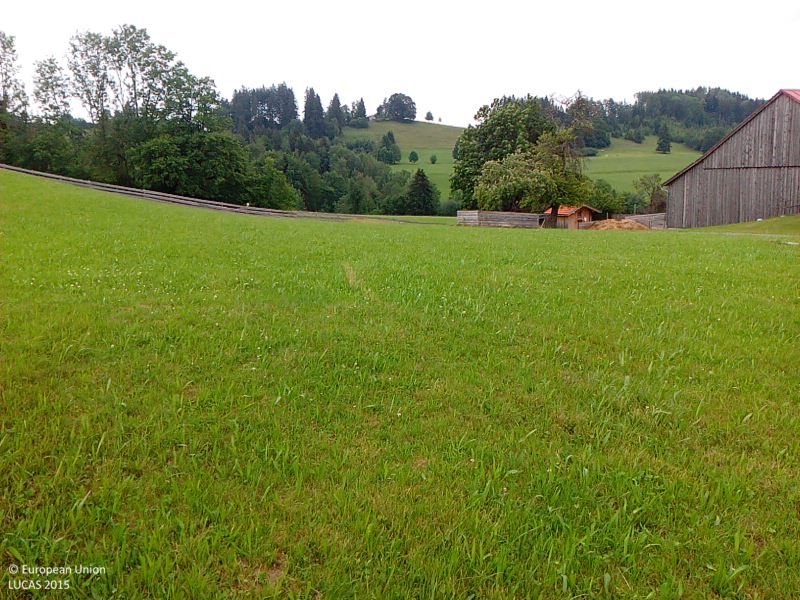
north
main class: Grassland
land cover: Grassland without tree/shrub cover
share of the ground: > 75 %
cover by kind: herbaceous plants 100 %
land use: Agriculture (excluding fallow land and kitchen gardens)
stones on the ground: < 10 %
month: June
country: DE
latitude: 47.6473
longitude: 10.2527
